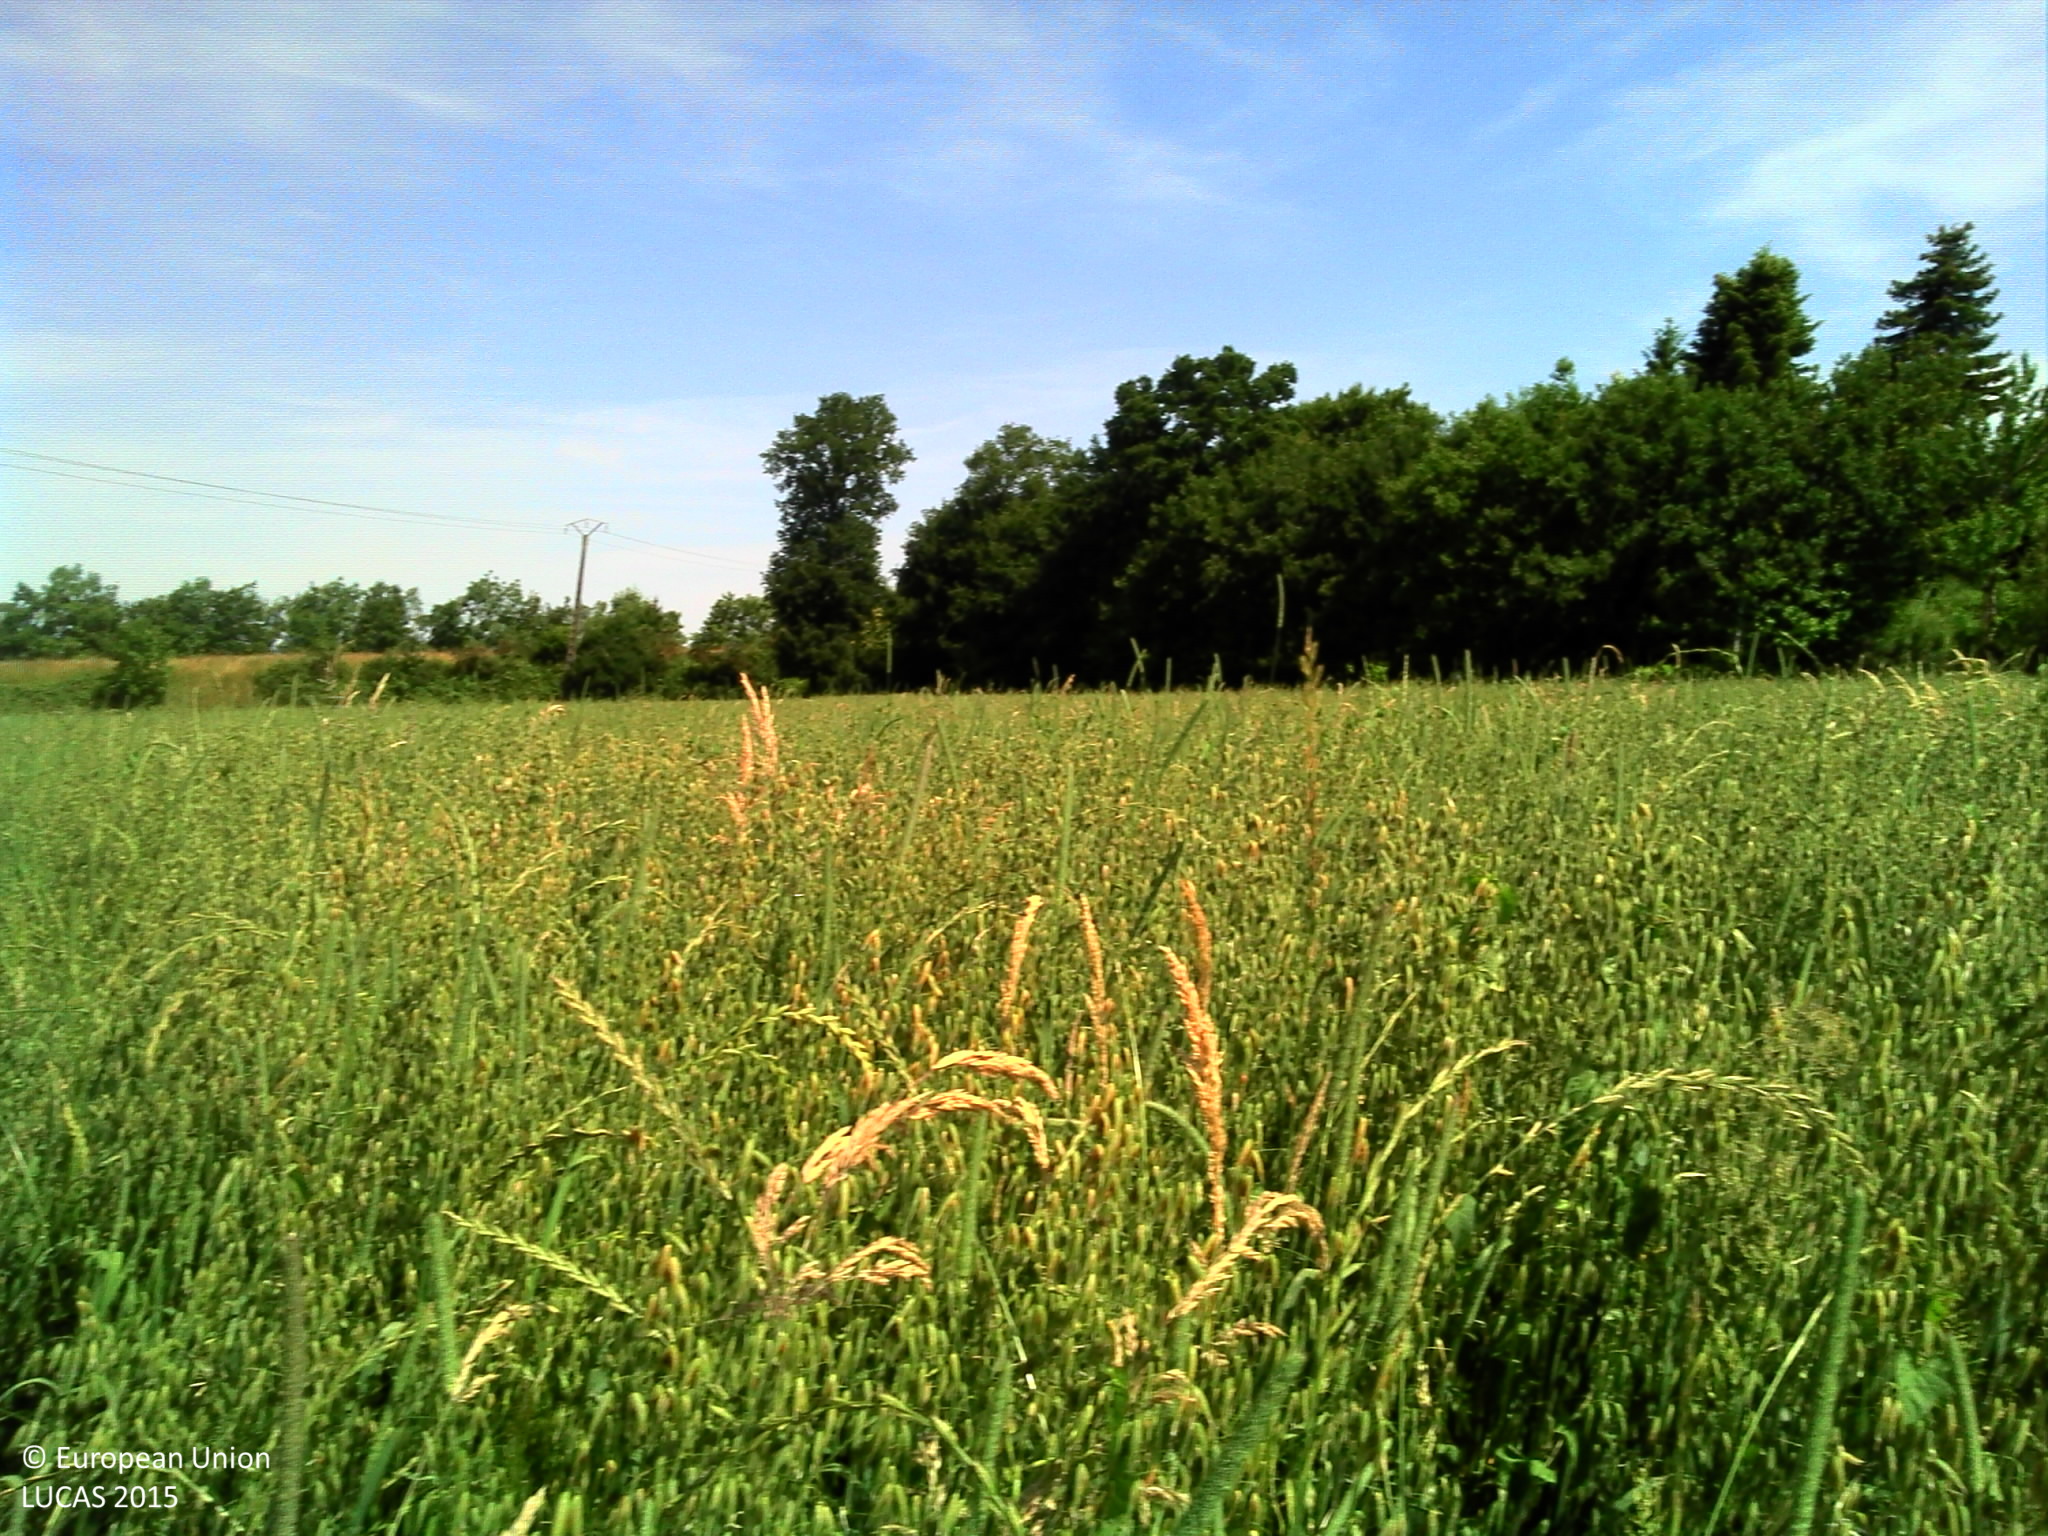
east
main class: Cropland
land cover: Oats
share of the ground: > 75 %
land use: Agriculture (excluding fallow land and kitchen gardens)
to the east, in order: Oats; Single bushes/trees; Oats; Electric lines; Oats; Fences; Lines of trees; Paved roads, cycling and walking lanes; Lines of trees; Grass margins; Barley
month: June
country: FR
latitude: 47.9908
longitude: -2.1002
